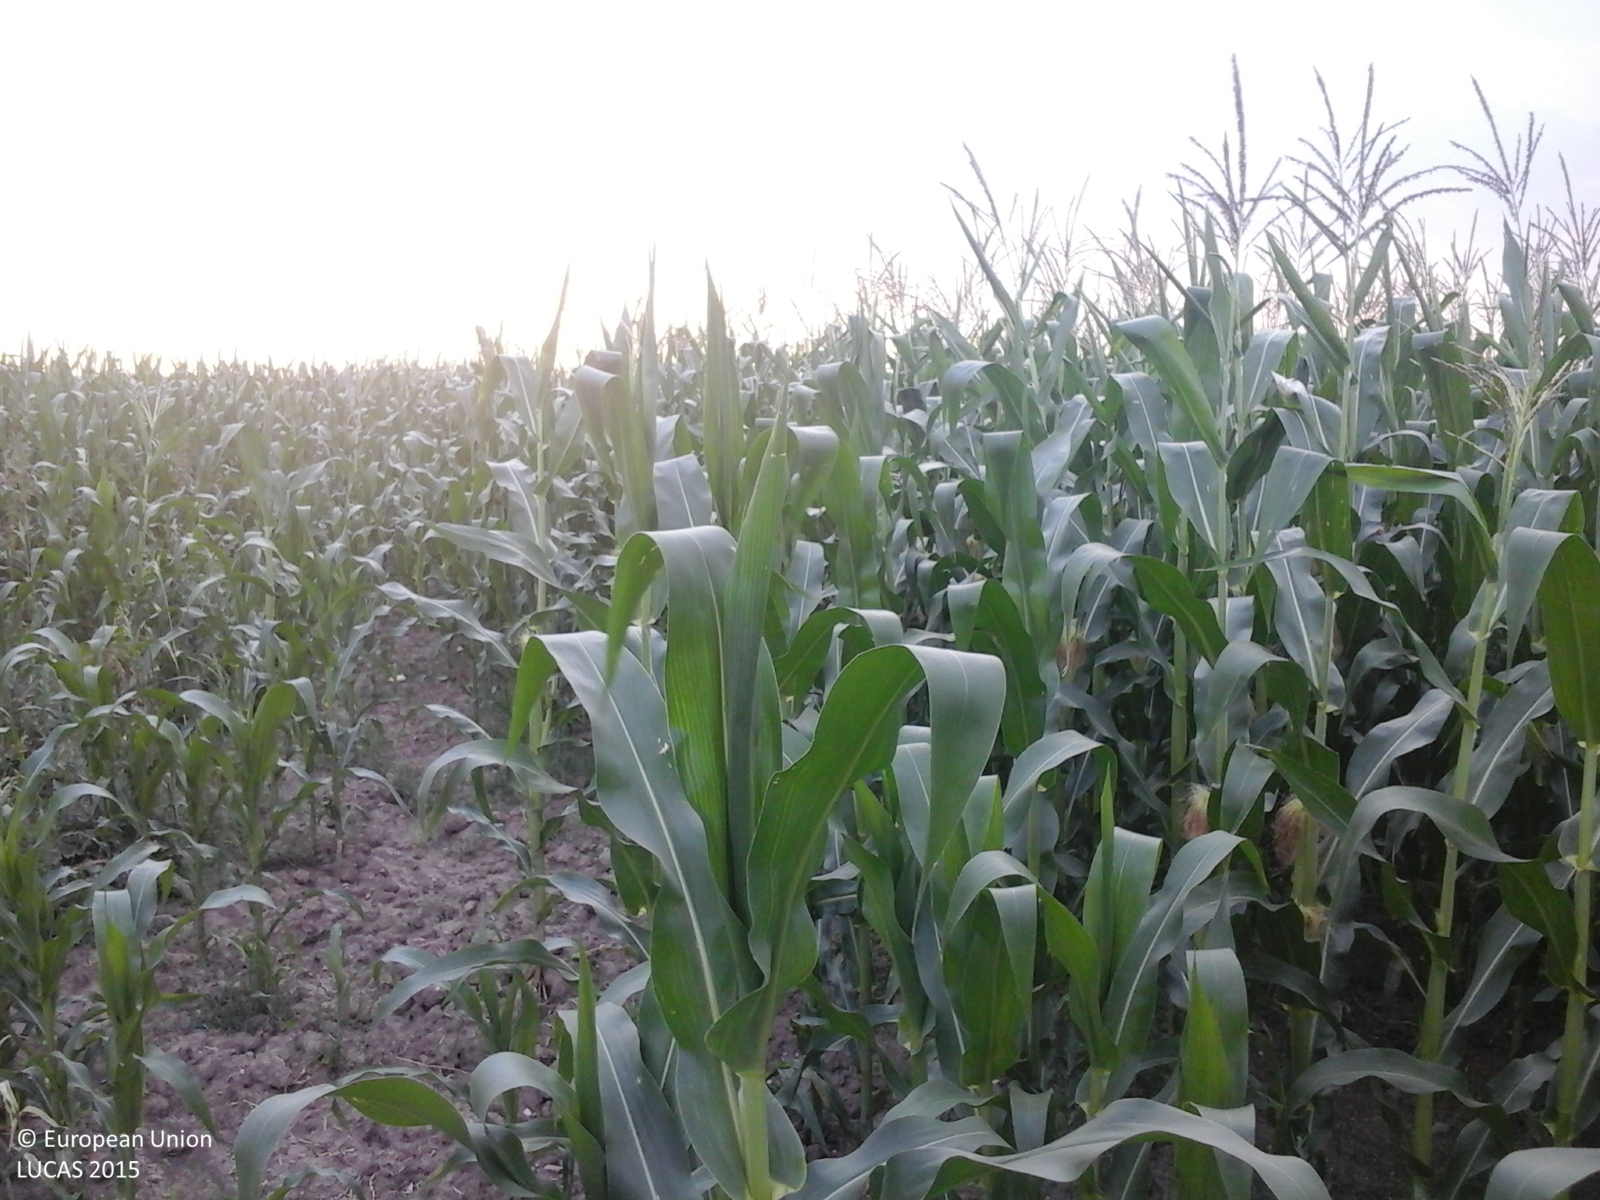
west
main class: Cropland
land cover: Maize
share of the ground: > 75 %
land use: Agriculture (excluding fallow land and kitchen gardens)
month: July
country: RO
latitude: 43.8696
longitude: 24.6648
